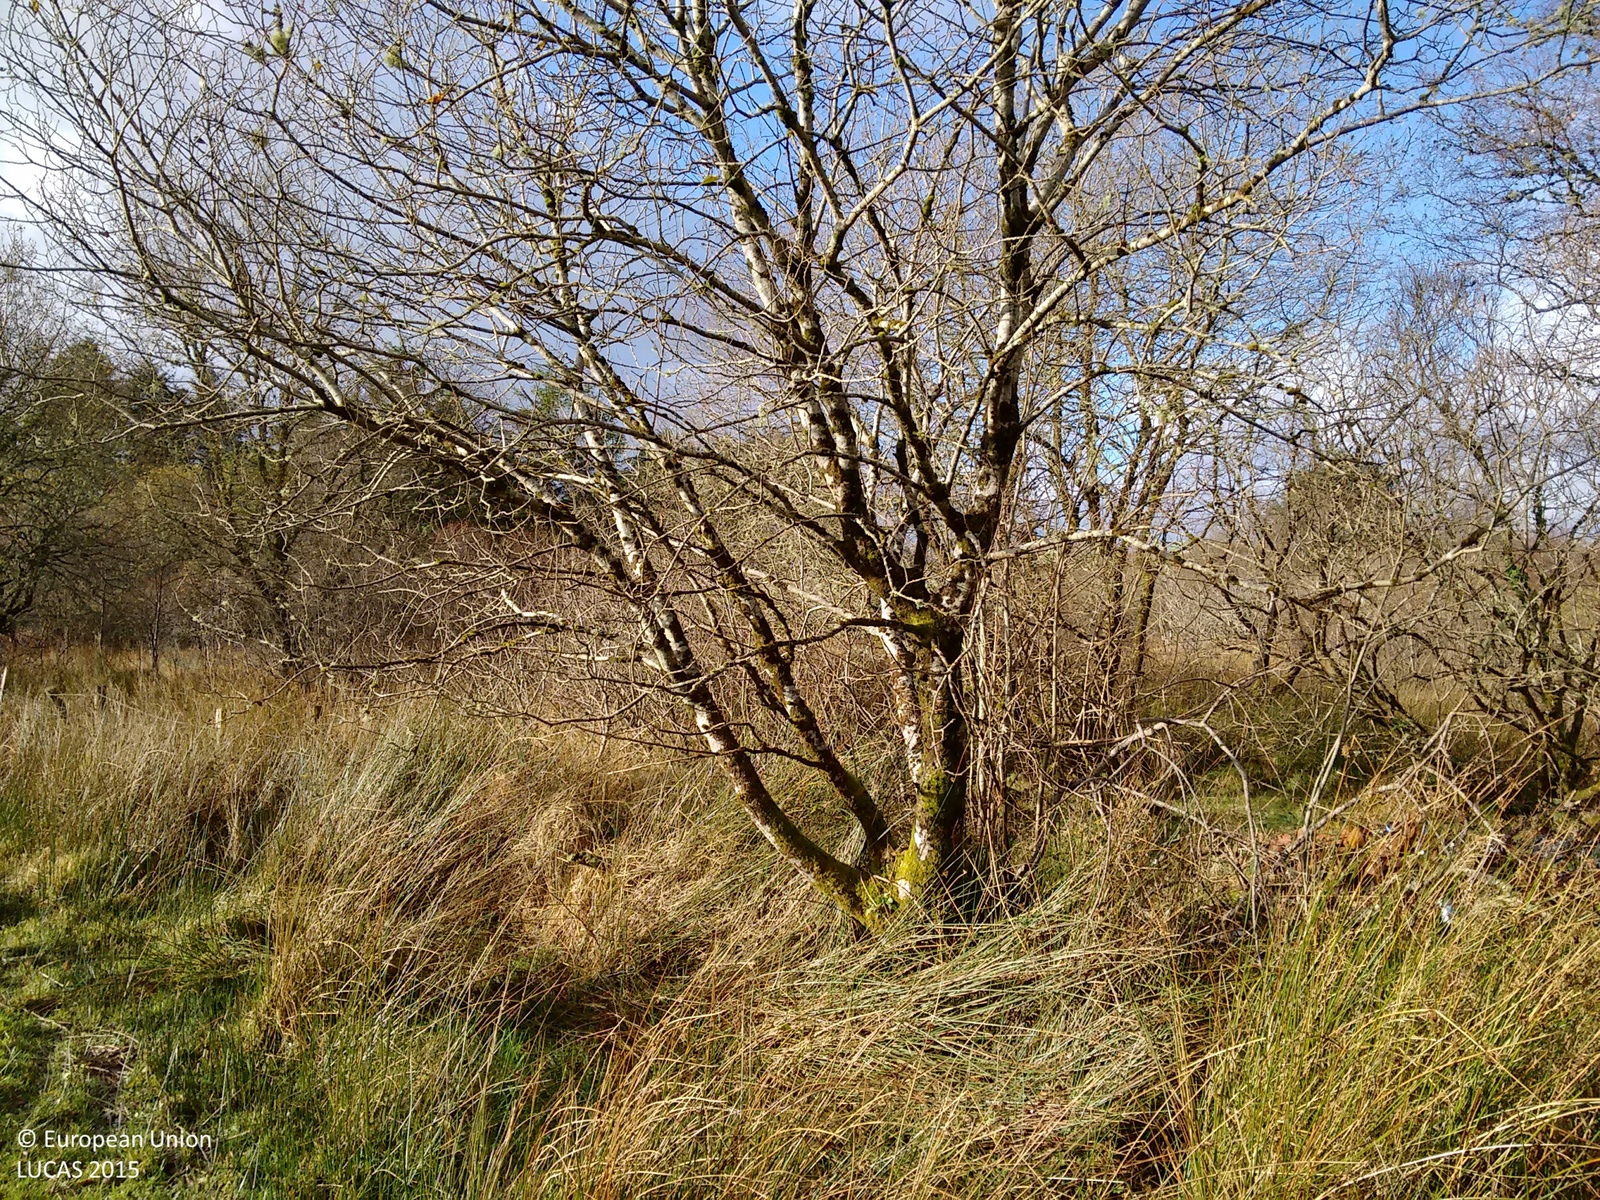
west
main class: Grassland
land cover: Grassland without tree/shrub cover
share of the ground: > 75 %
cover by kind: herbaceous plants 100 %
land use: Agriculture (excluding fallow land and kitchen gardens)
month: November
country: IE
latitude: 54.6681
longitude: -8.1804
